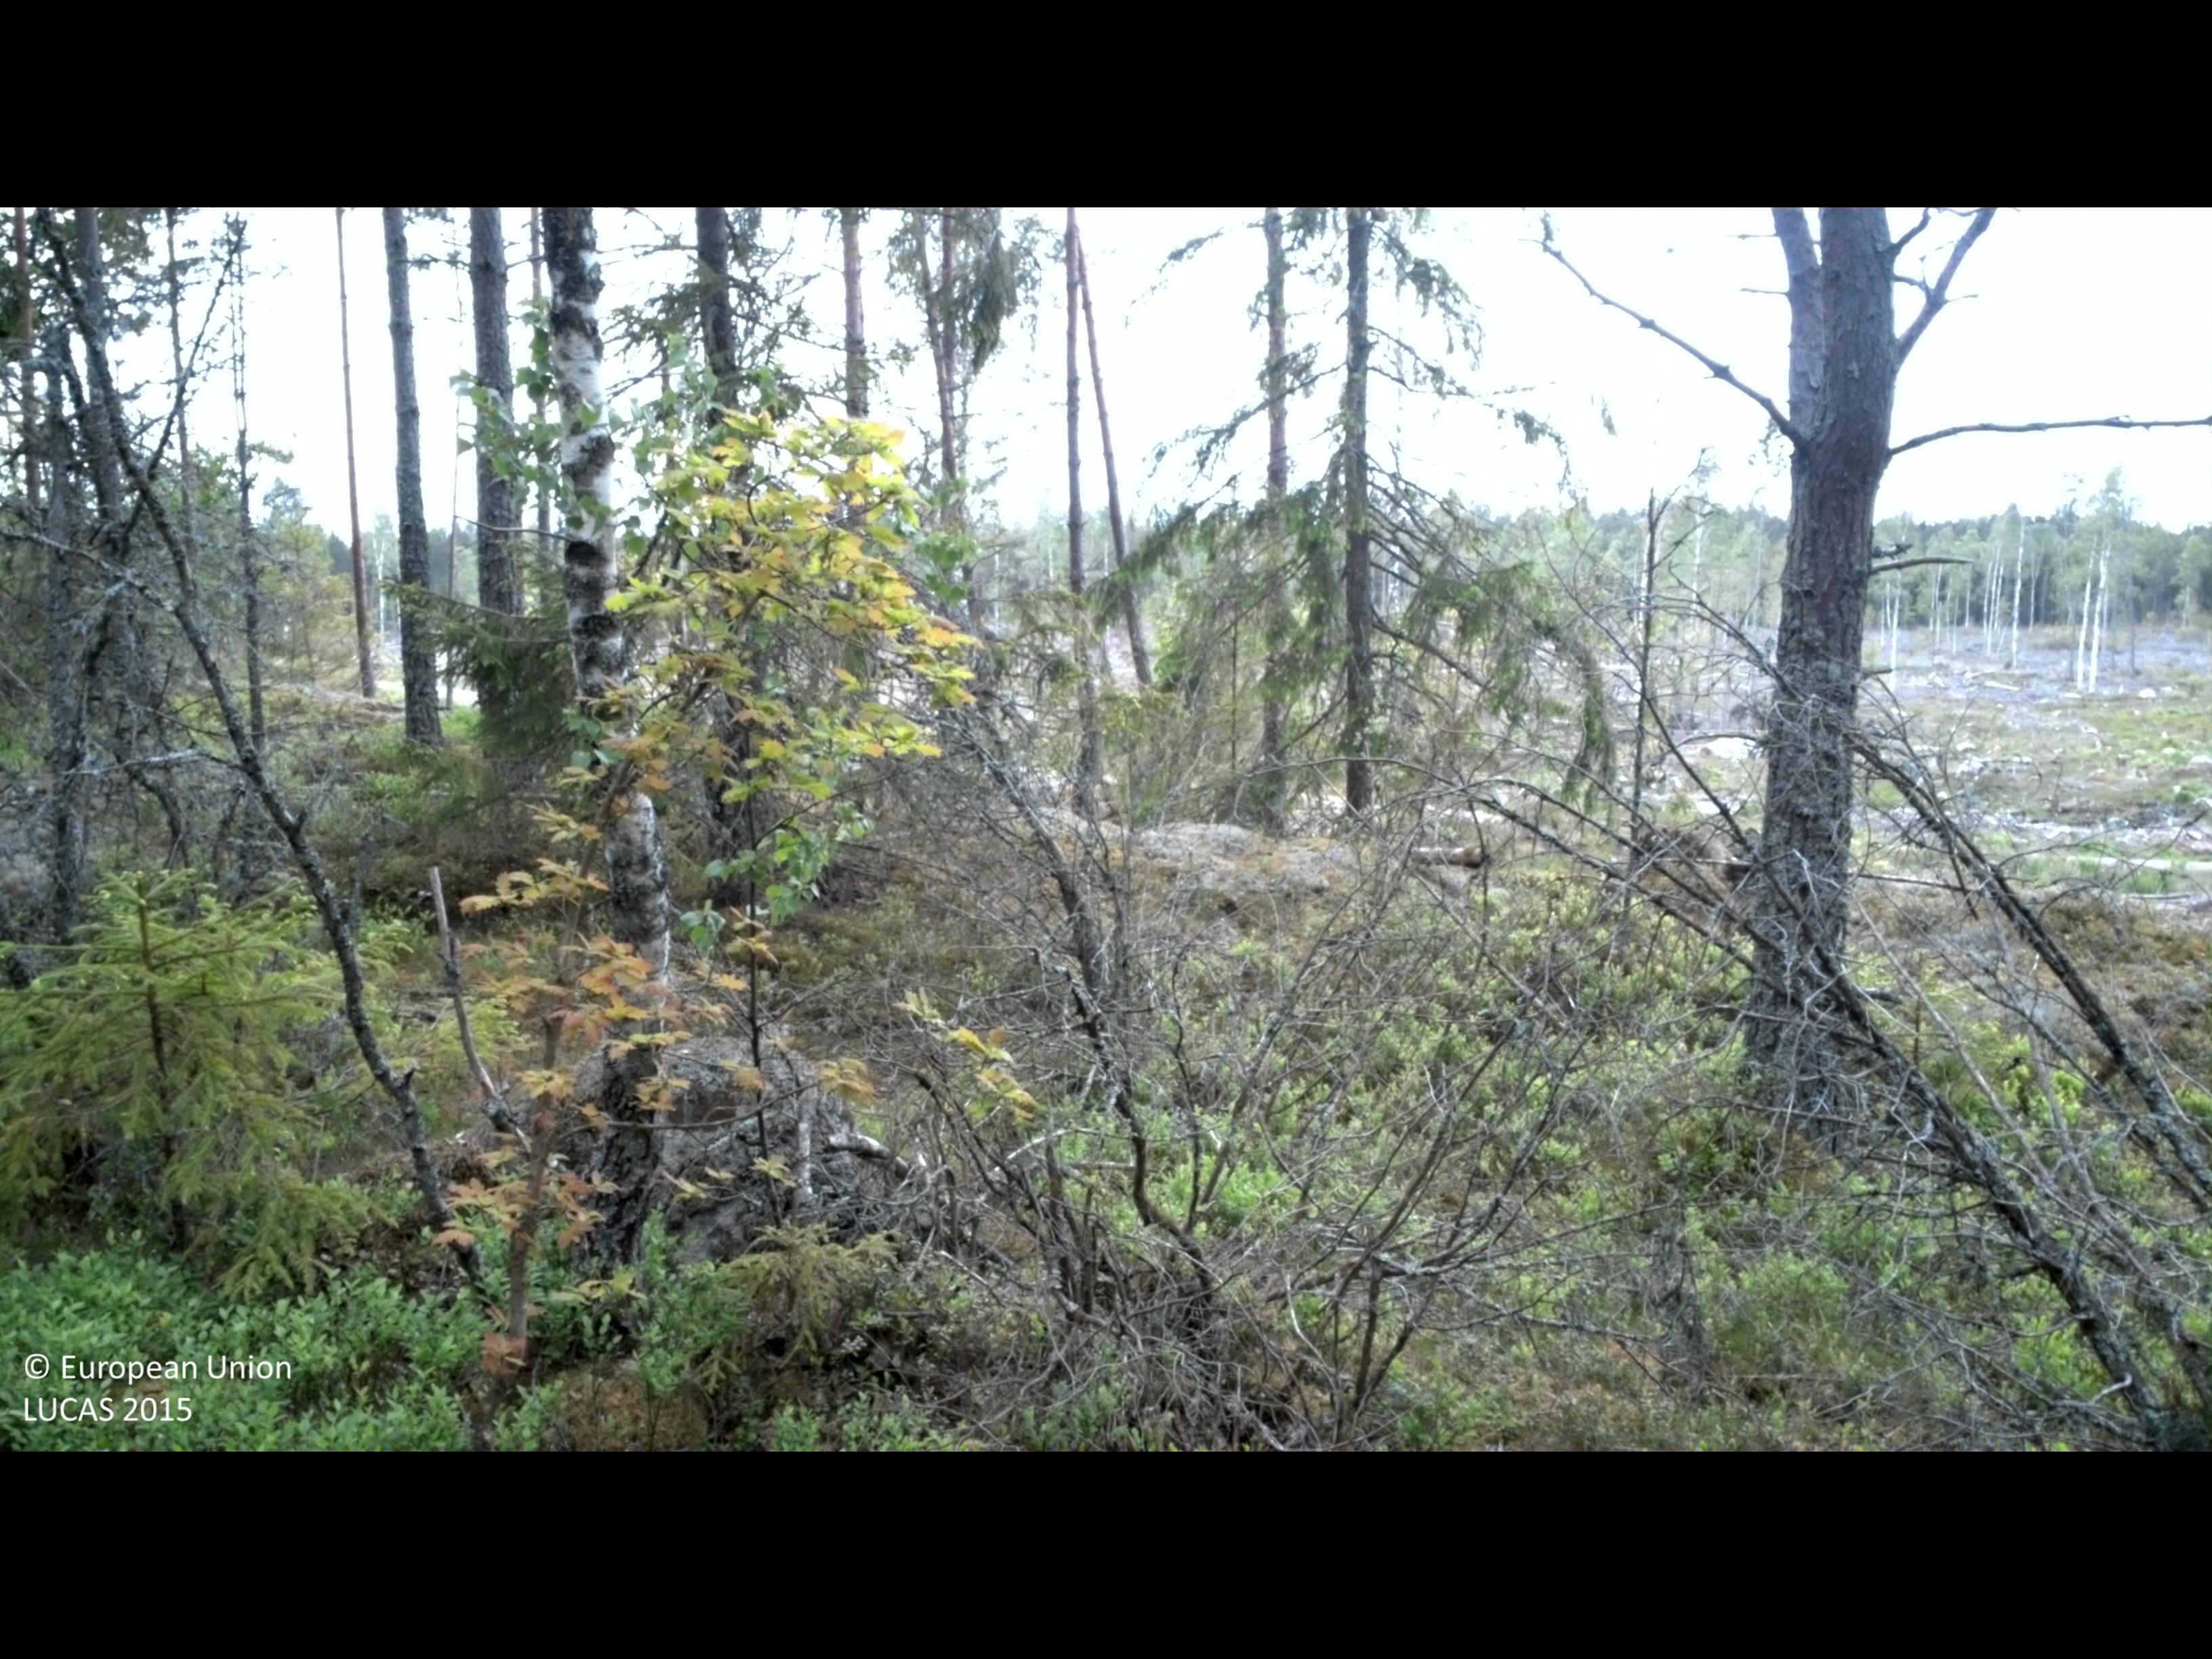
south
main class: Woodland
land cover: Pine dominated coniferous woodland
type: boreal forest
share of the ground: 50 - 75 %
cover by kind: coniferous forest trees 50 %, shrubs 25 %, lichens and mosses 15 %, broadleaved forest trees 10 %
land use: Forestry
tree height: > 5 m
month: June
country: SE
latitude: 57.6607
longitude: 16.2162
